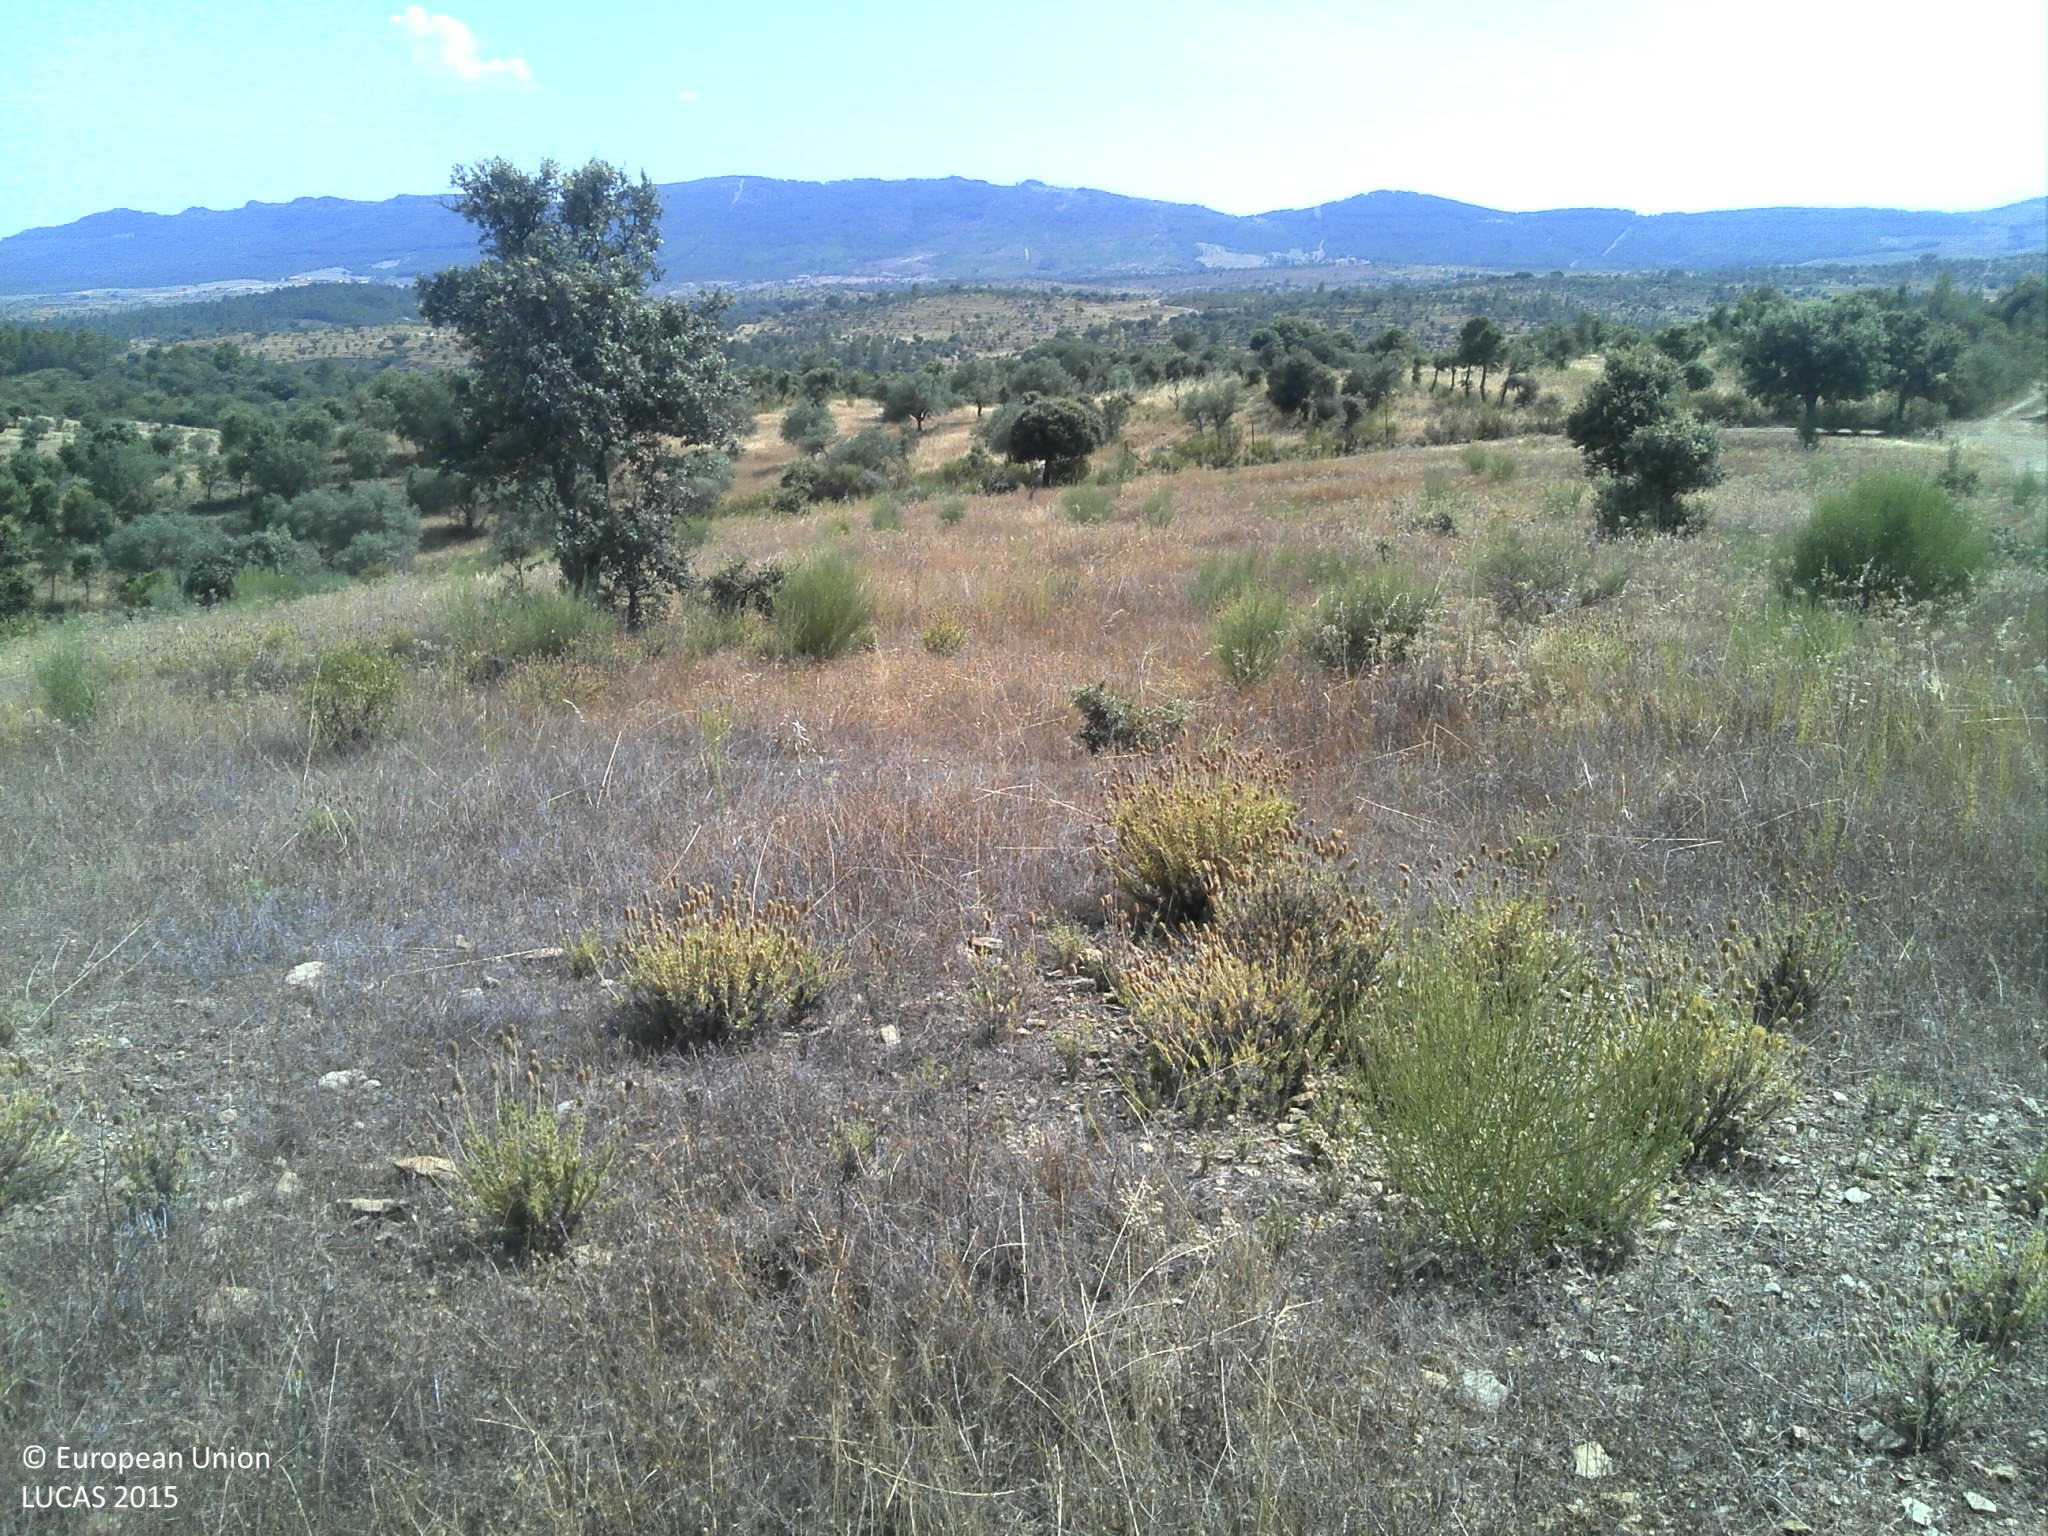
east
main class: Grassland
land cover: Grassland with sparse tree/shrub cover
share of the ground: 25 - 50 %
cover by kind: herbaceous plants 45 %, unconsolidated bare surface 40 %, broadleaved forest trees 5 %, shrubs 5 %
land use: Agriculture (excluding fallow land and kitchen gardens)
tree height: > 5 m
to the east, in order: Grassland with sparse tree/shrub cover; Ditches and canals; Grassland with sparse tree/shrub cover; Dry stone walls; Fences; Broadleaved woodland; Ditches and canals; Grass margins
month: June
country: PT
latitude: 40.1404
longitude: -7.0786
